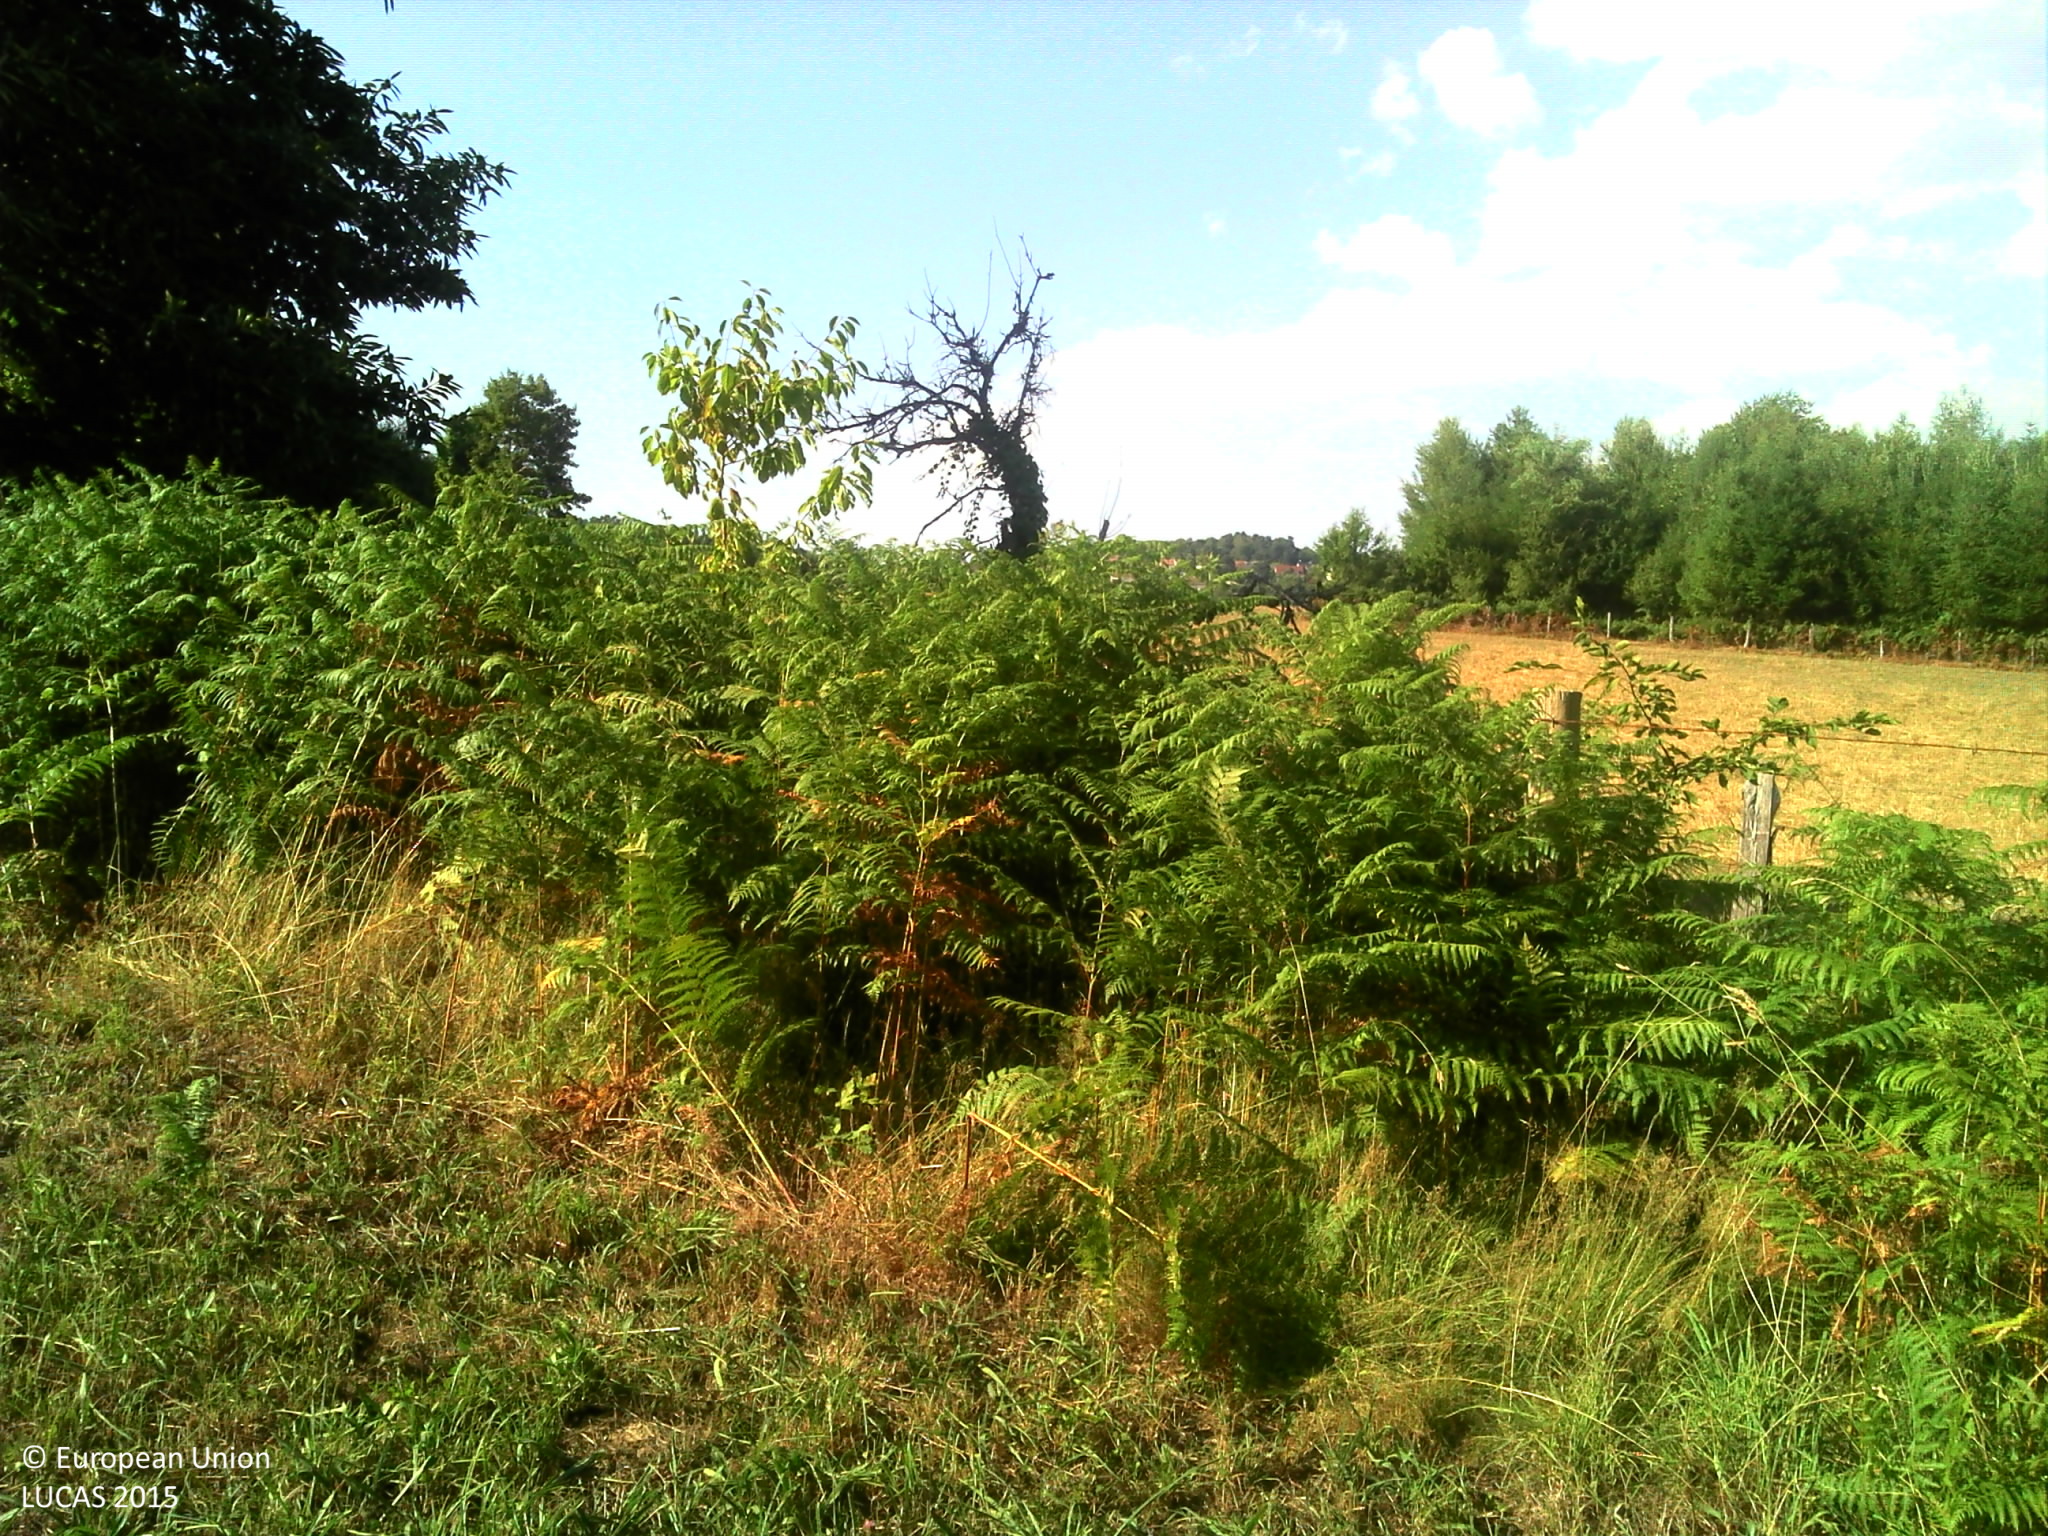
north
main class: Grassland
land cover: Grassland with sparse tree/shrub cover
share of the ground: > 75 %
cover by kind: herbaceous plants 85 %, shrubs 10 %, broadleaved forest trees 5 %
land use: Agriculture (excluding fallow land and kitchen gardens)
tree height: > 5 m
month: August
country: FR
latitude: 45.2497
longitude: 1.7012
